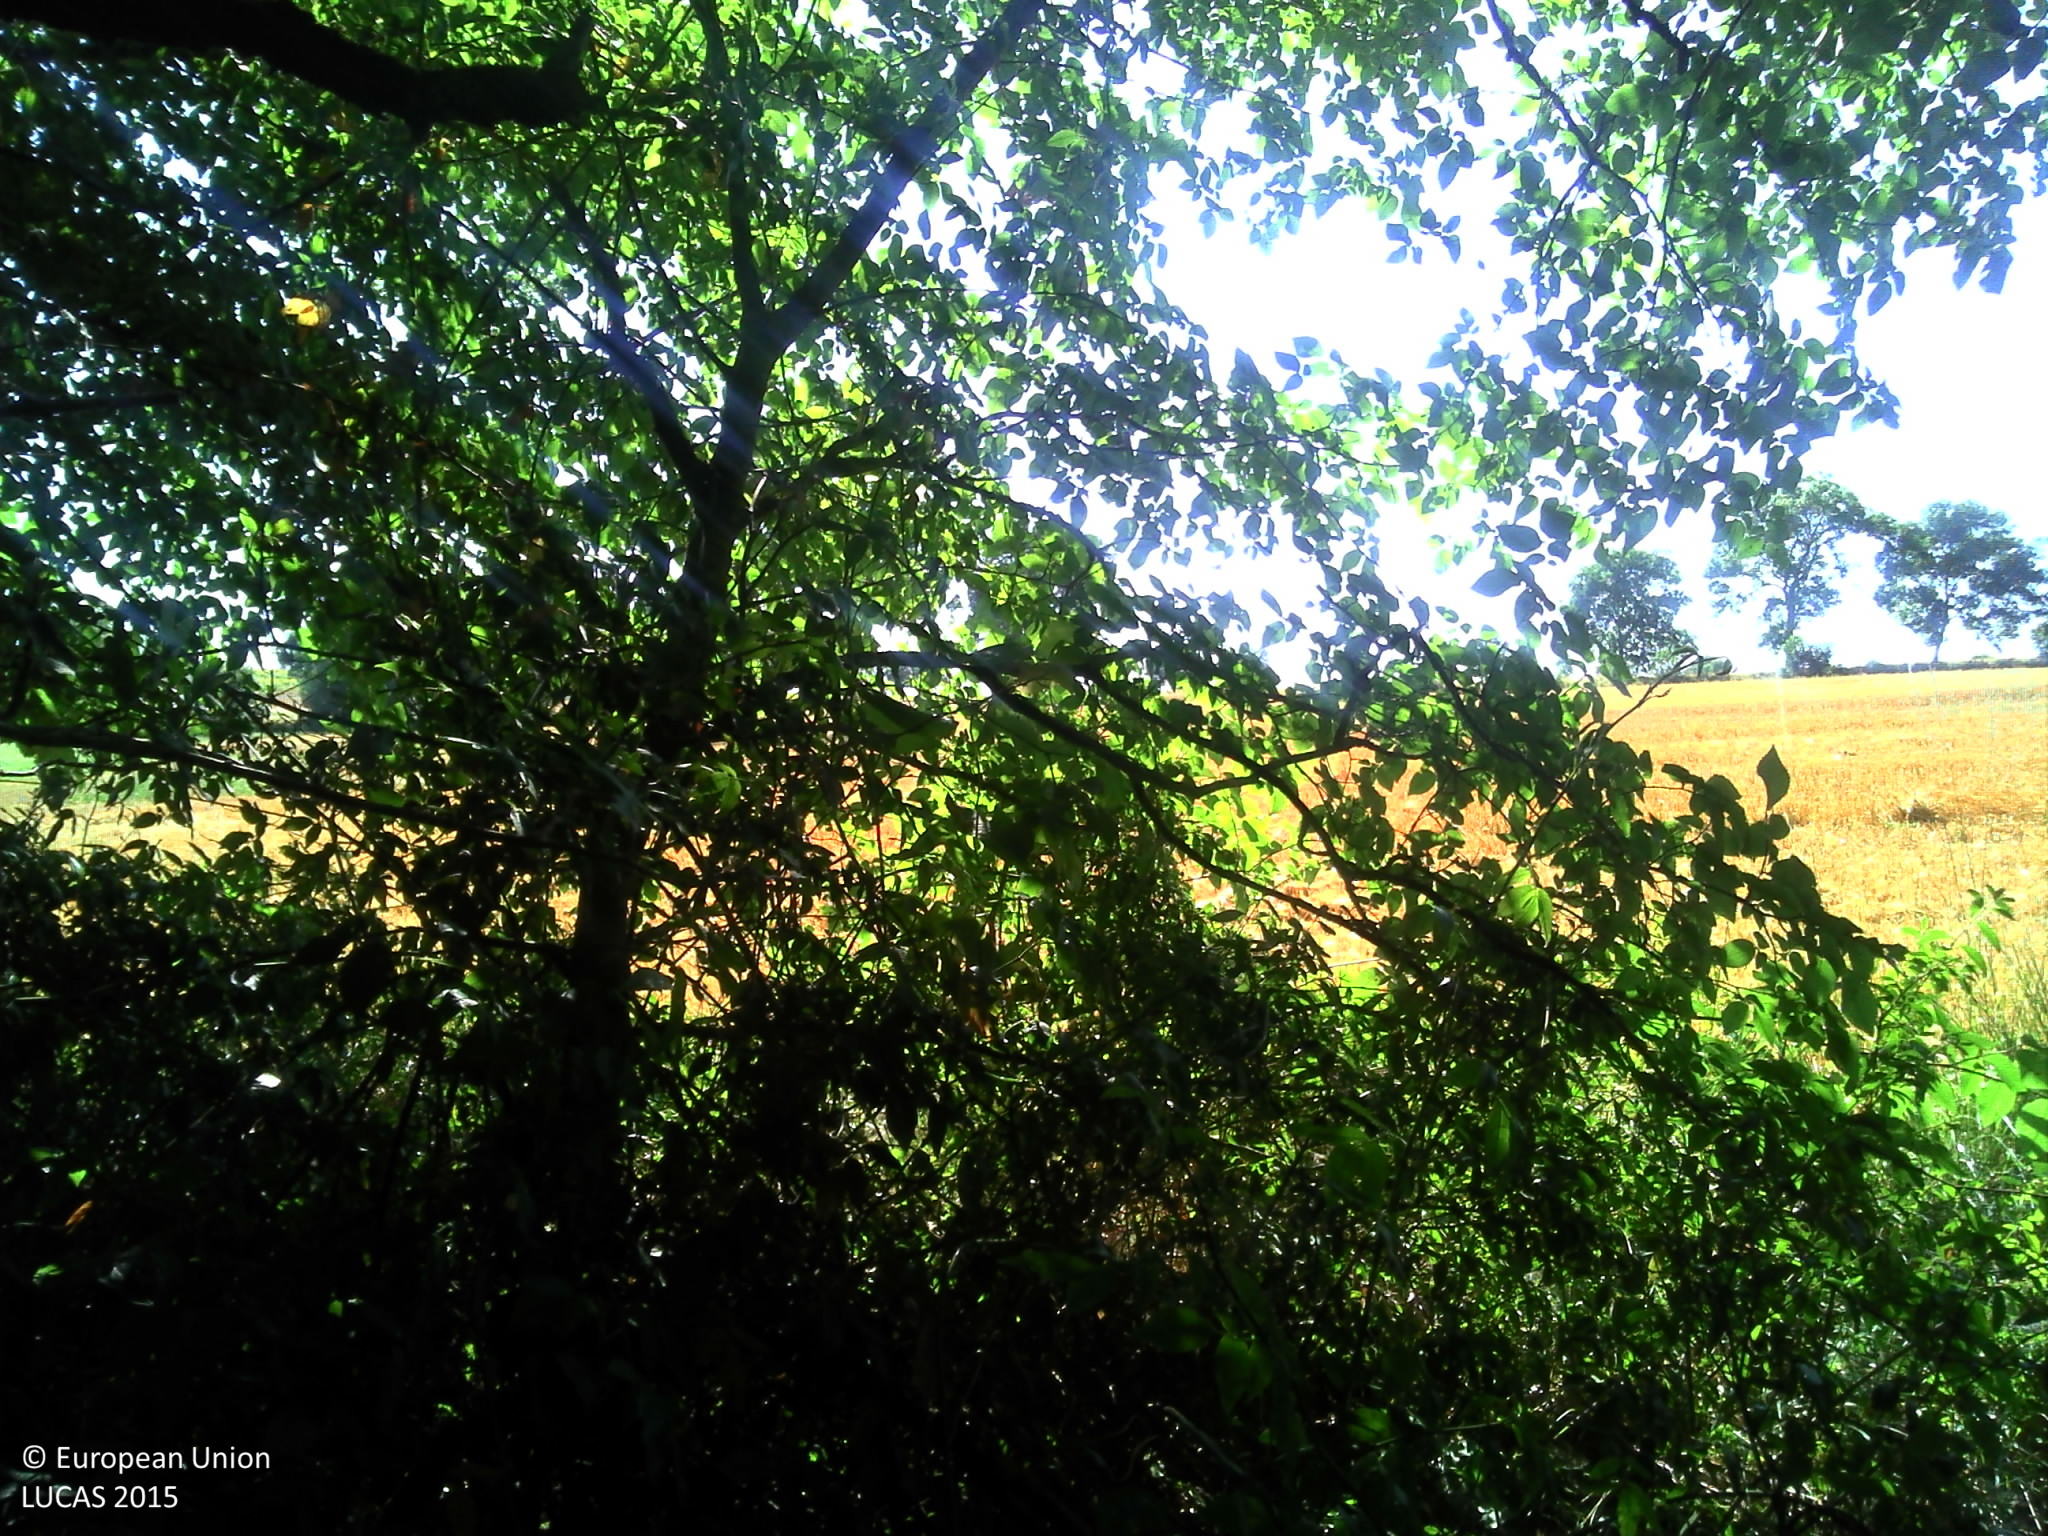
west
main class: Woodland
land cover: Broadleaved woodland
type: thermophilous deciduous forest
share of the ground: > 75 %
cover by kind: broadleaved forest trees 80 %, shrubs 10 %, herbaceous plants 10 %
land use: Forestry
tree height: > 5 m
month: July
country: FR
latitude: 43.8442
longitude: 0.7308
